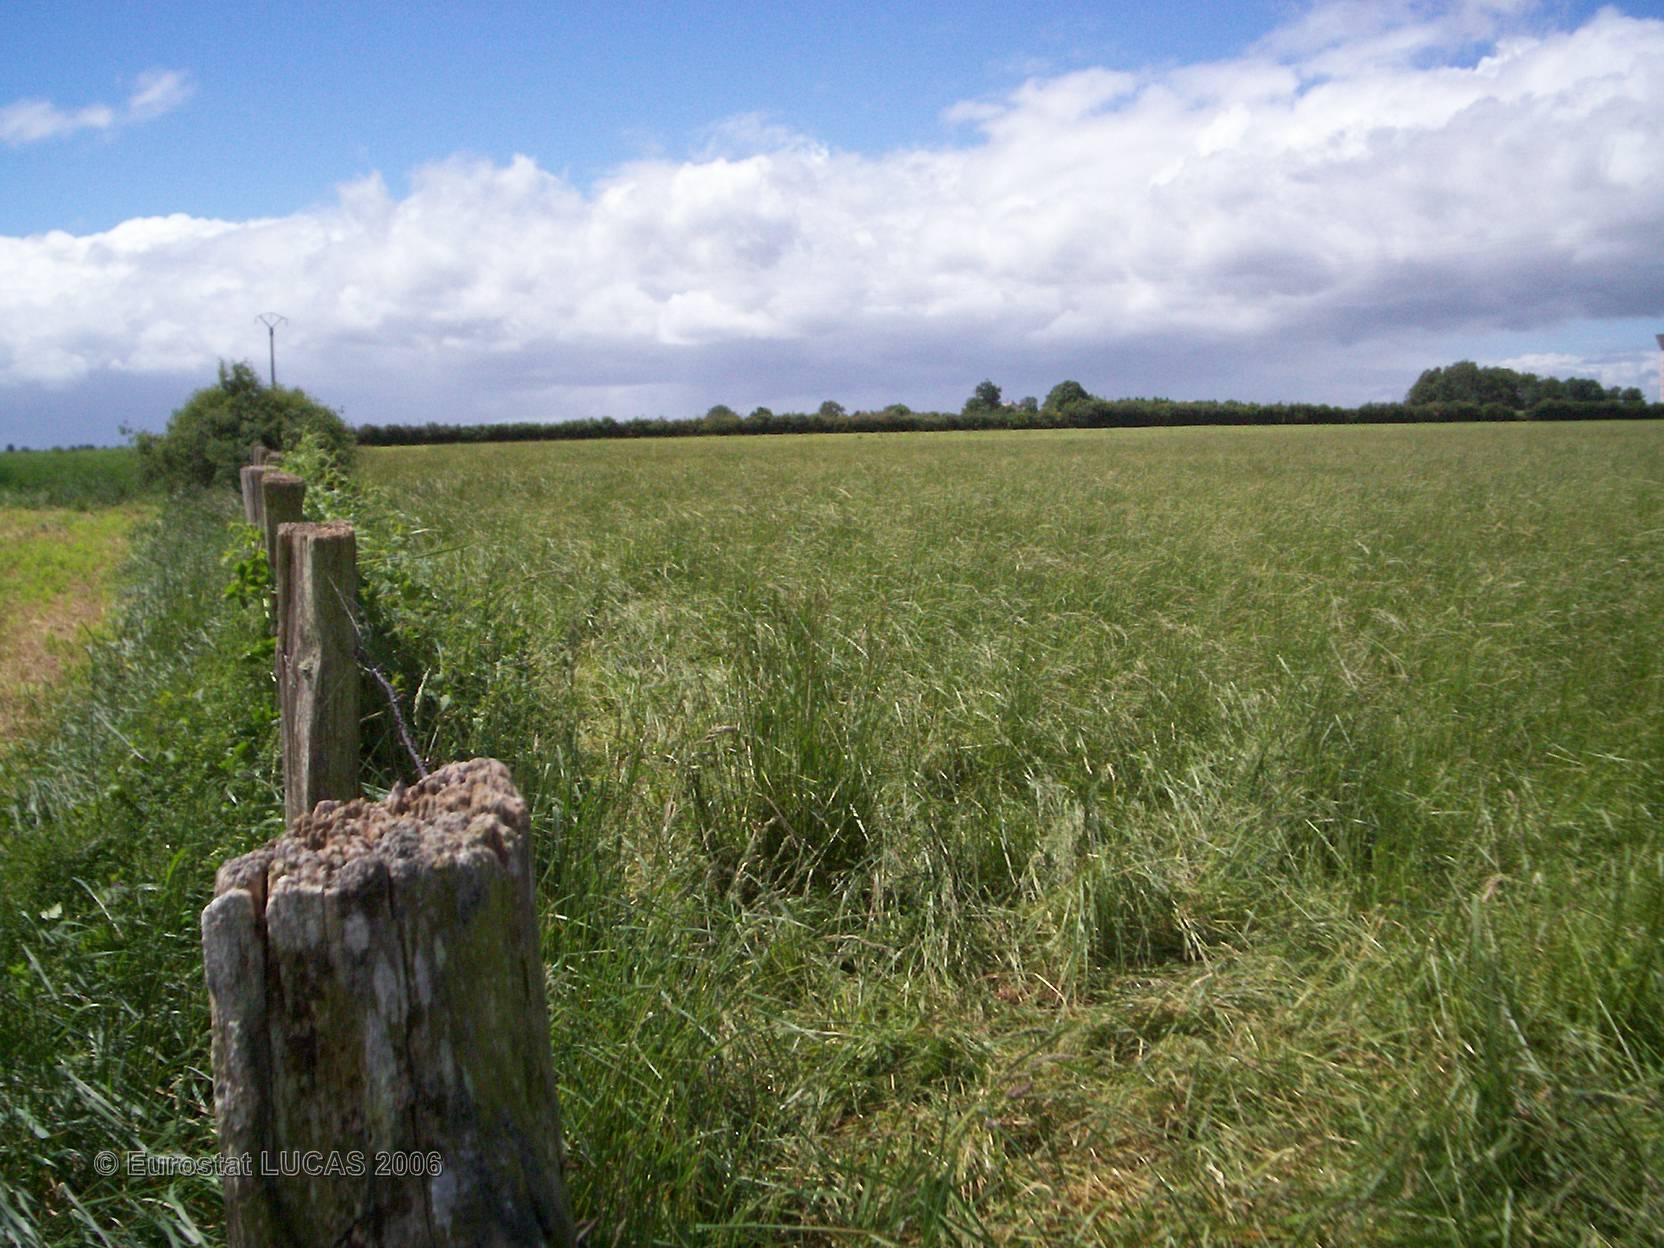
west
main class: Grassland
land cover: Grassland without tree/shrub cover
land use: Agriculture (excluding fallow land and kitchen gardens)
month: May
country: FR
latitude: 47.6241
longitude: 0.8393
